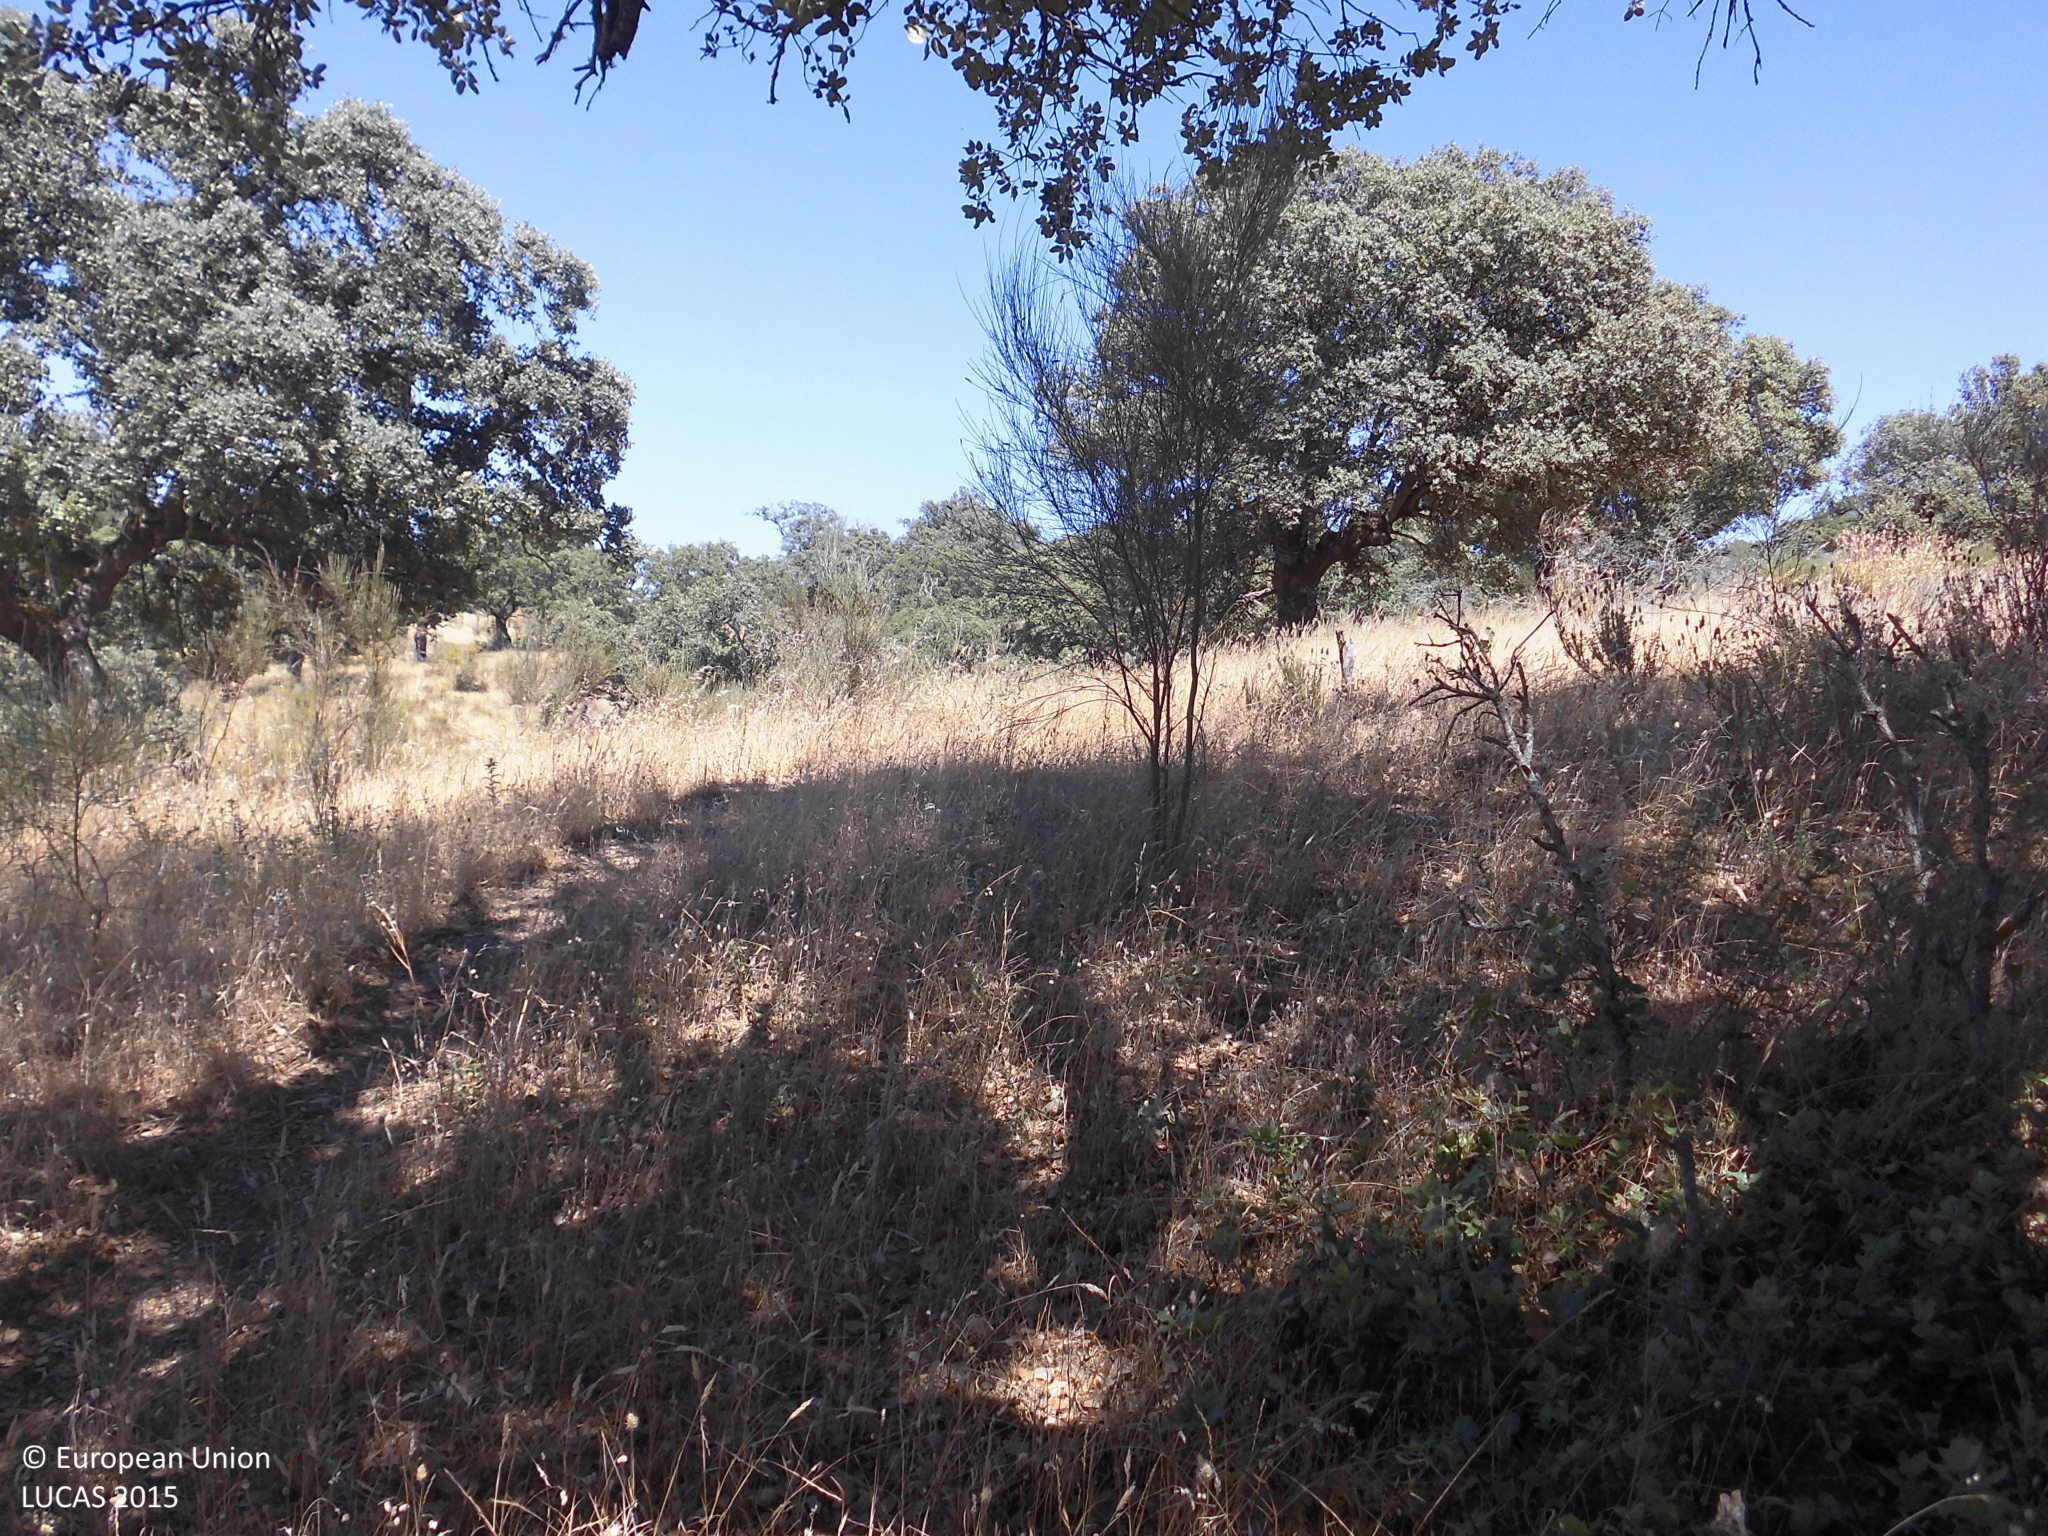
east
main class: Woodland
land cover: Broadleaved woodland
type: broadleaved evergreen forest
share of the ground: 25 - 50 %
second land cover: Grassland without tree/shrub cover
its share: > 75 %
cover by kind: herbaceous plants 65 %, broadleaved forest trees 25 %, shrubs 10 %
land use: Forestry
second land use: Agriculture (excluding fallow land and kitchen gardens)
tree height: > 5 m
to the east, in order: Broadleaved woodland; Grassland without tree/shrub cover; Rivers and streams; Broadleaved woodland; Rock outcrops; Broadleaved woodland; Rock outcrops; Broadleaved woodland
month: May
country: ES
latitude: 39.5505
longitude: -6.6584
